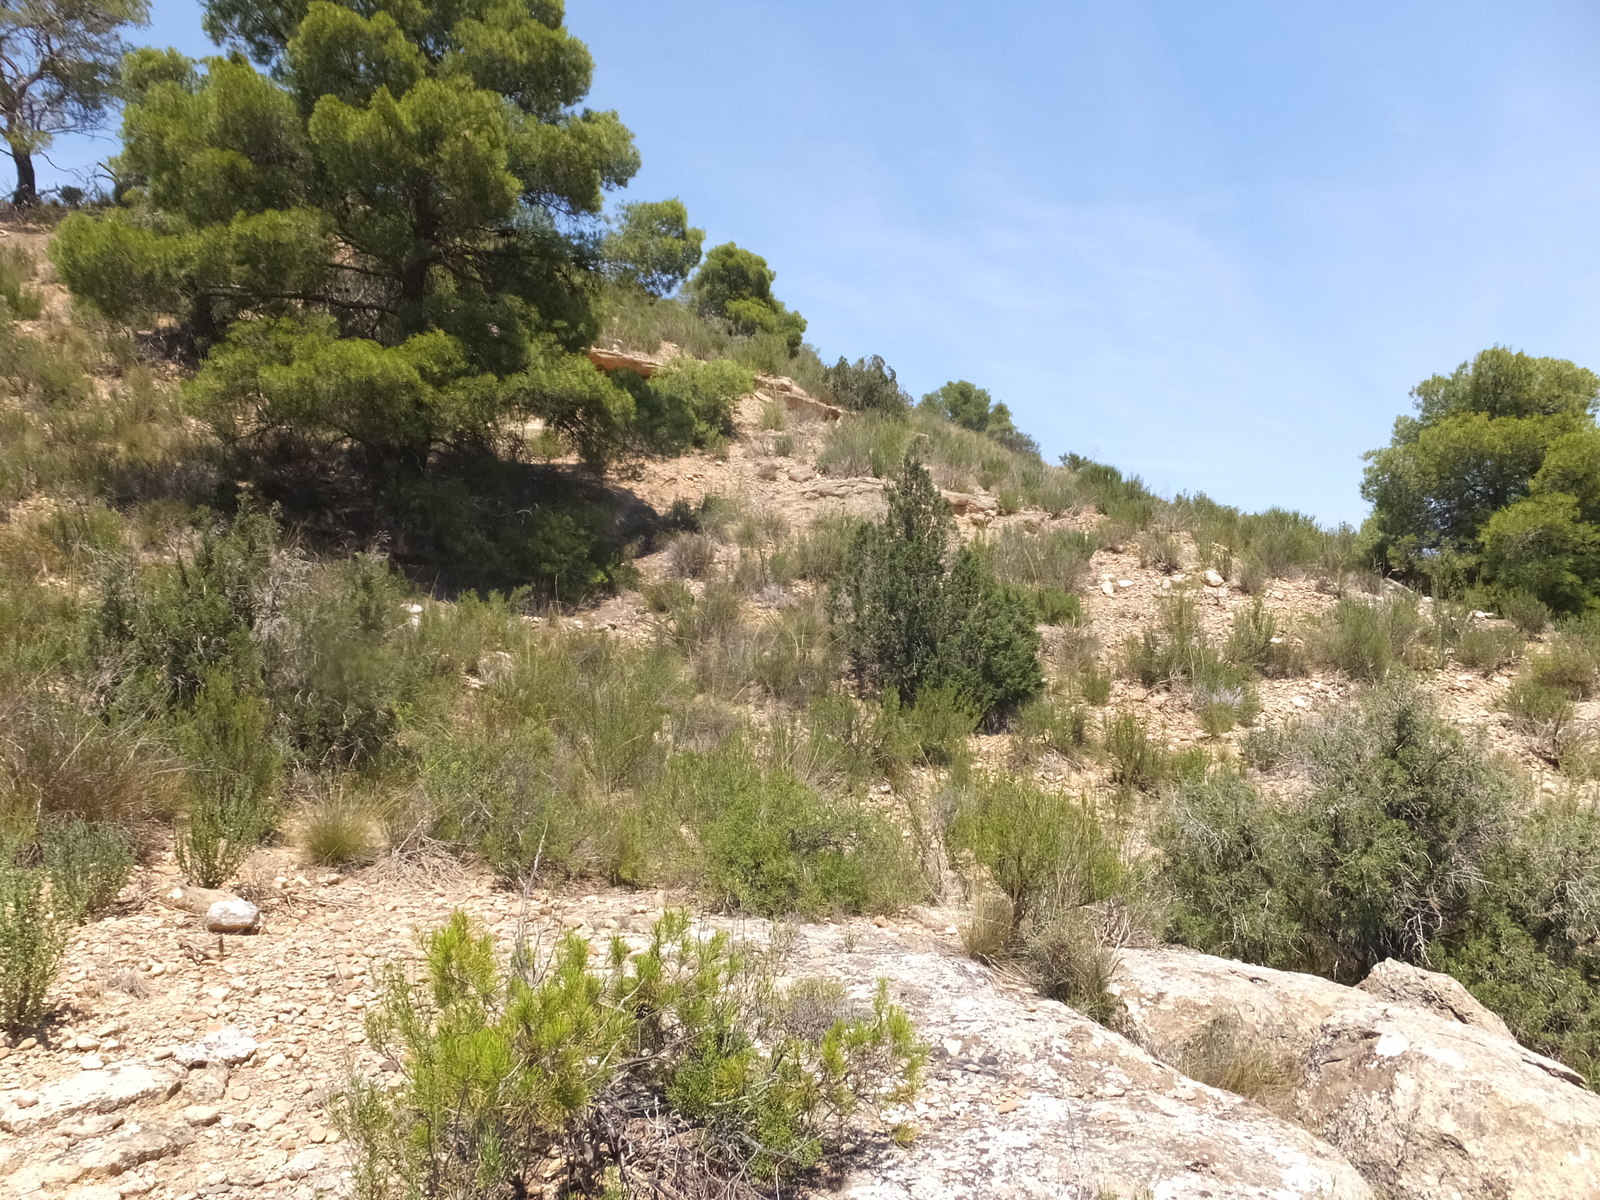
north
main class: Shrubland
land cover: Shrubland with sparse tree cover
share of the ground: > 75 %
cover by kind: shrubs 50 %, herbaceous plants 30 %, unconsolidated bare surface 10 %, coniferous forest trees 5 %, consolidated bare surface 5 %
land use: Semi-natural and natural areas not in use
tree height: < 5 m
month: June
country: ES
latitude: 41.3031
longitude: -0.1777
